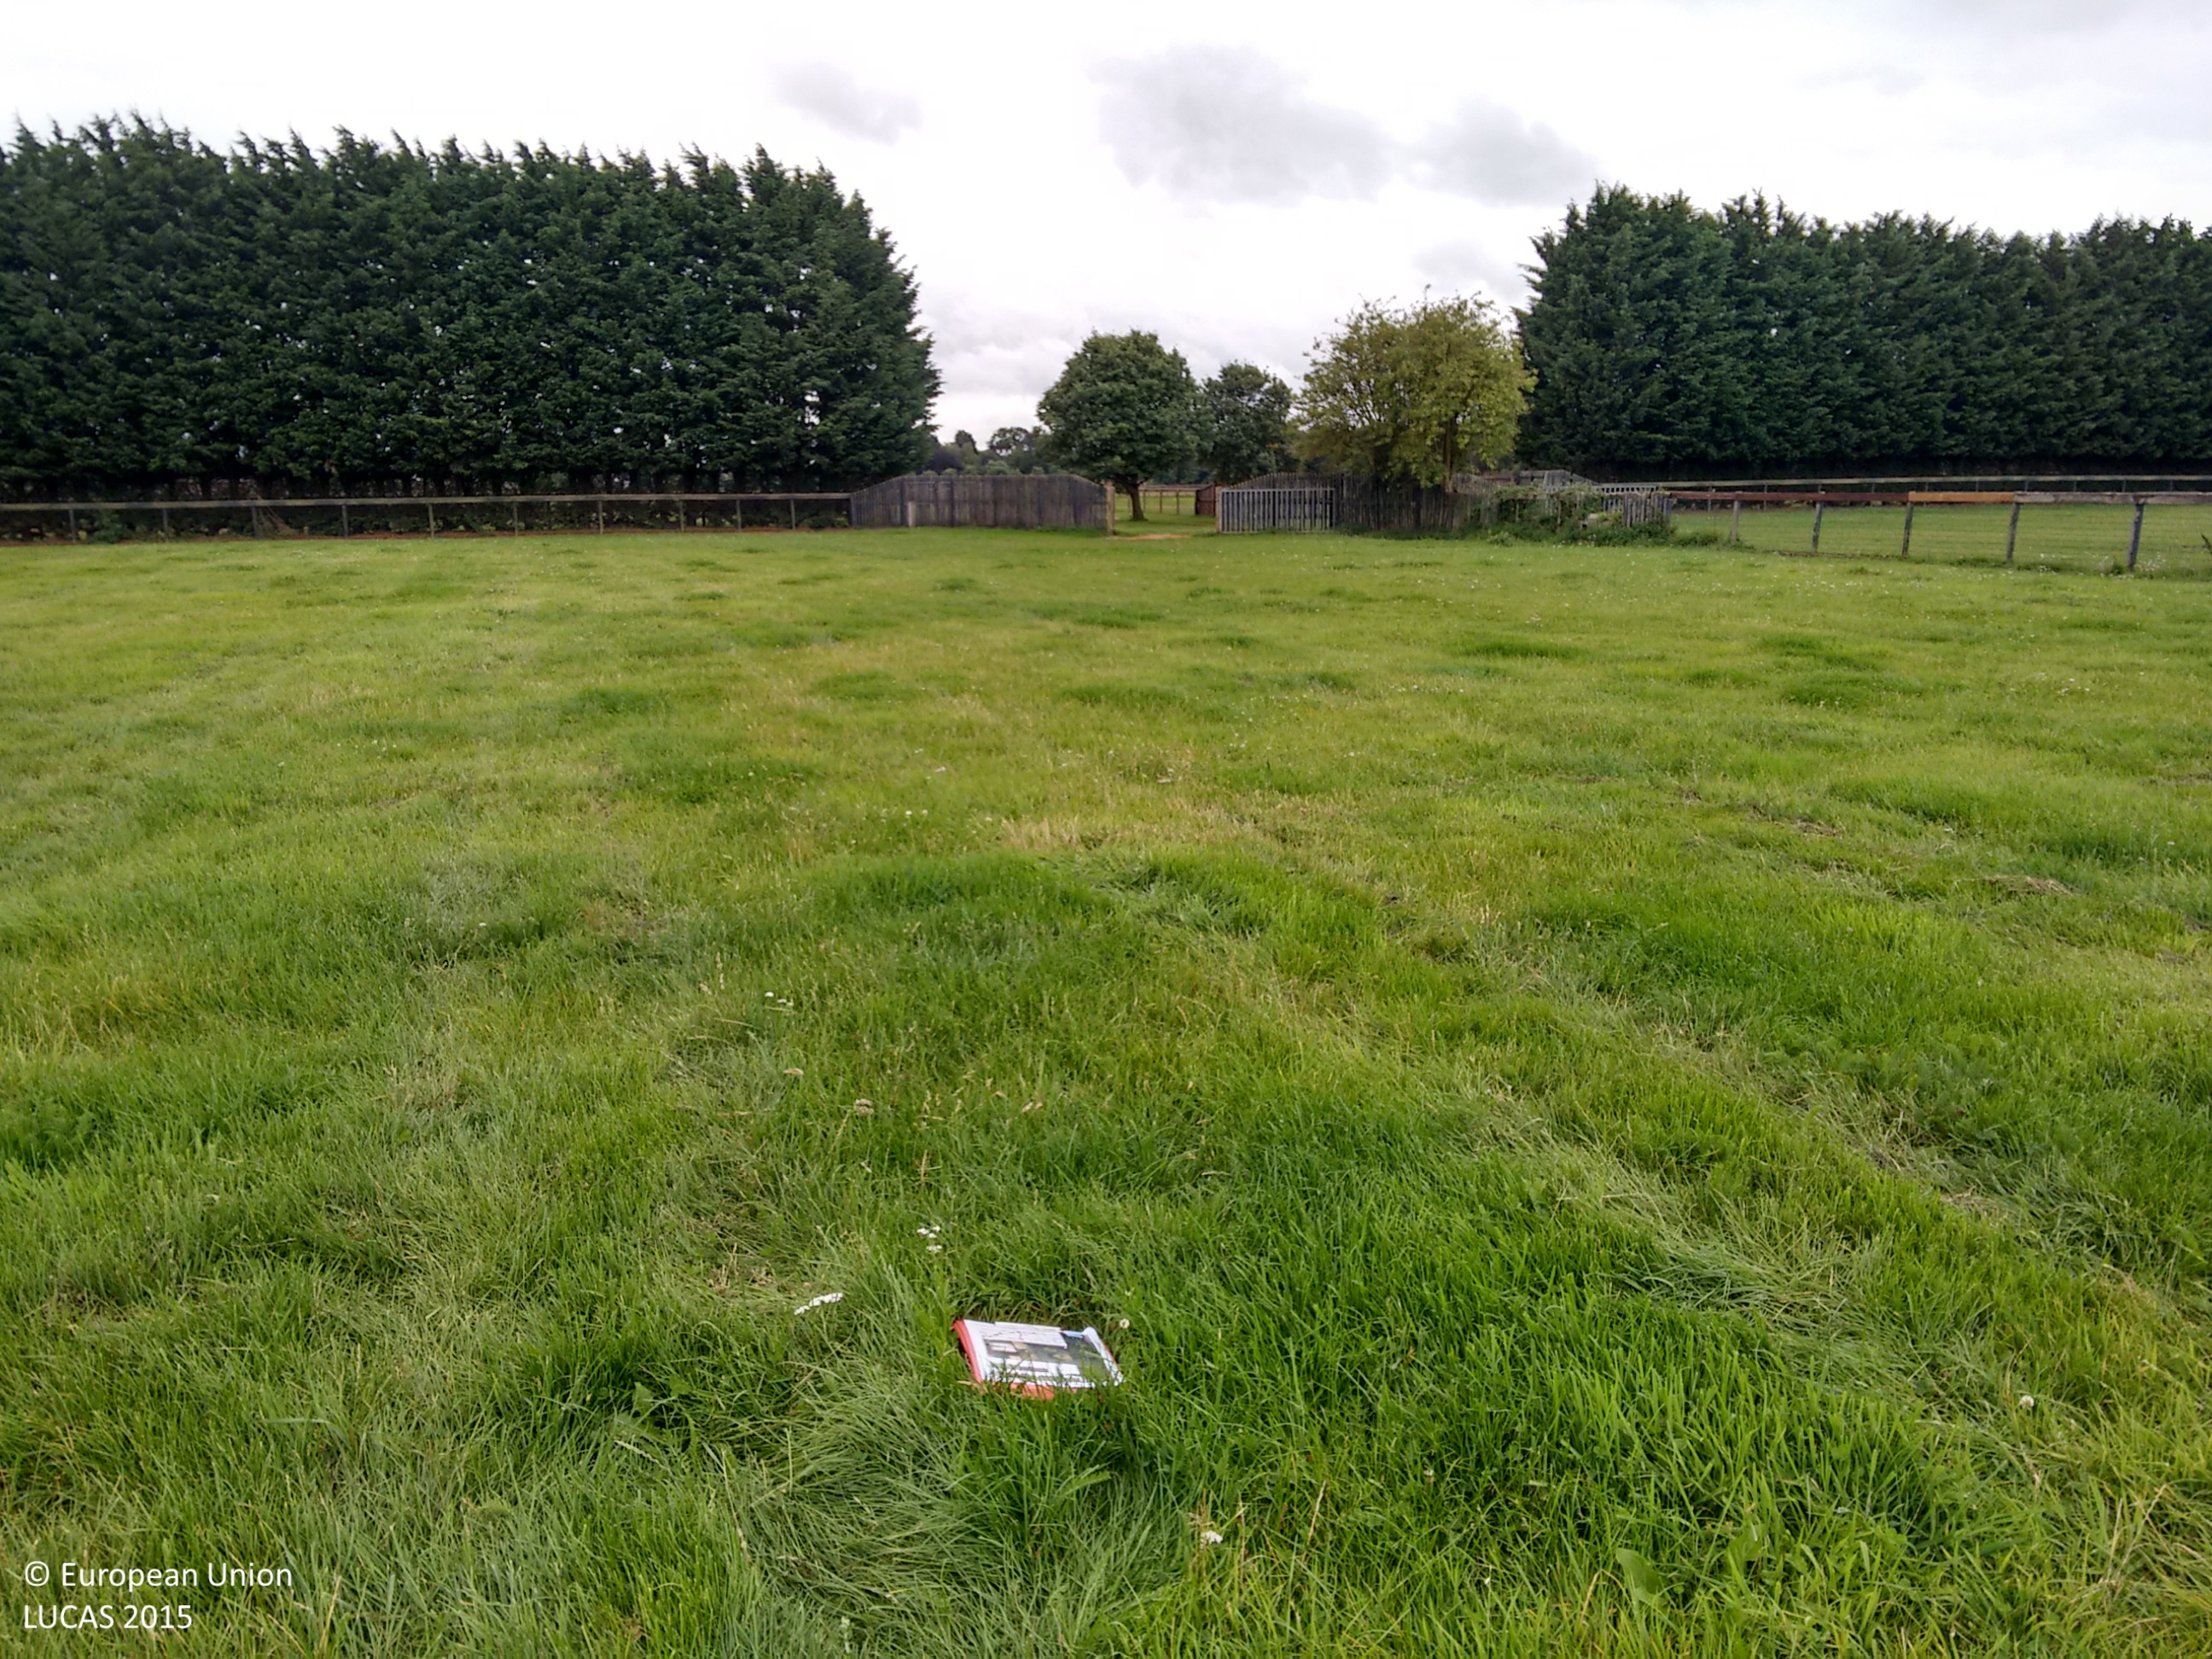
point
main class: Grassland
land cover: Grassland without tree/shrub cover
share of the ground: > 75 %
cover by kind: herbaceous plants 100 %
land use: Agriculture (excluding fallow land and kitchen gardens)
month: August
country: GB
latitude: 52.3247
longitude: 0.5384
